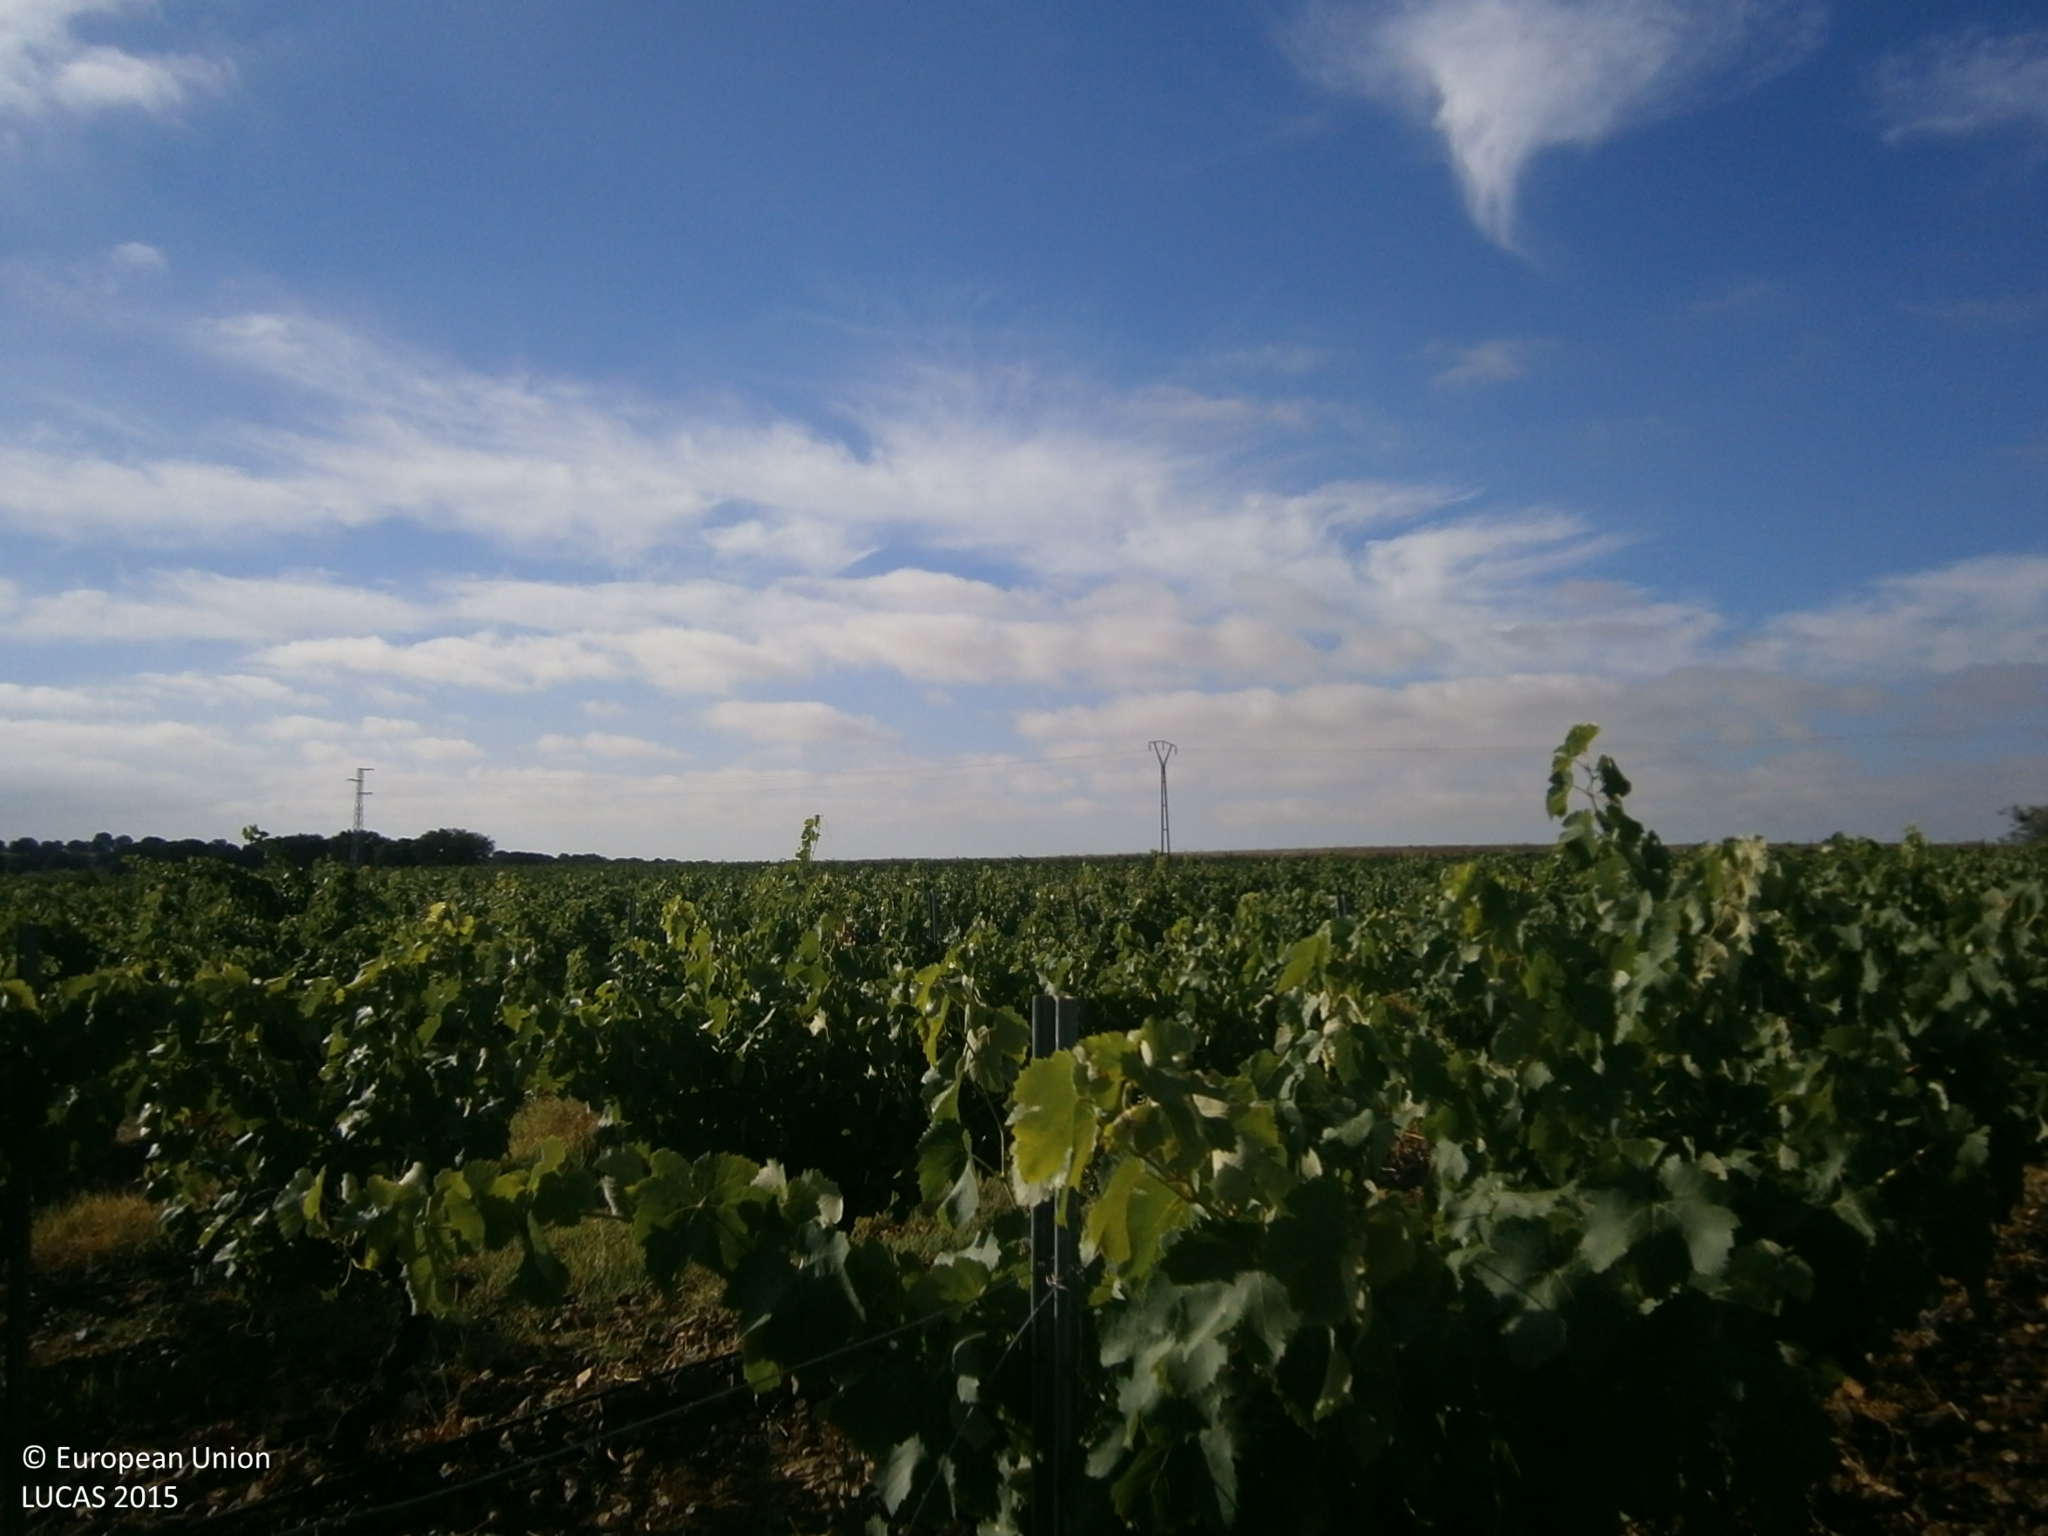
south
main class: Cropland
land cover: Vineyards
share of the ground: 25 - 50 %
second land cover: Spontaneously vegetated surfaces
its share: 25 - 50 %
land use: Agriculture (excluding fallow land and kitchen gardens)
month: June
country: ES
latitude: 38.7153
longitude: -6.7967
